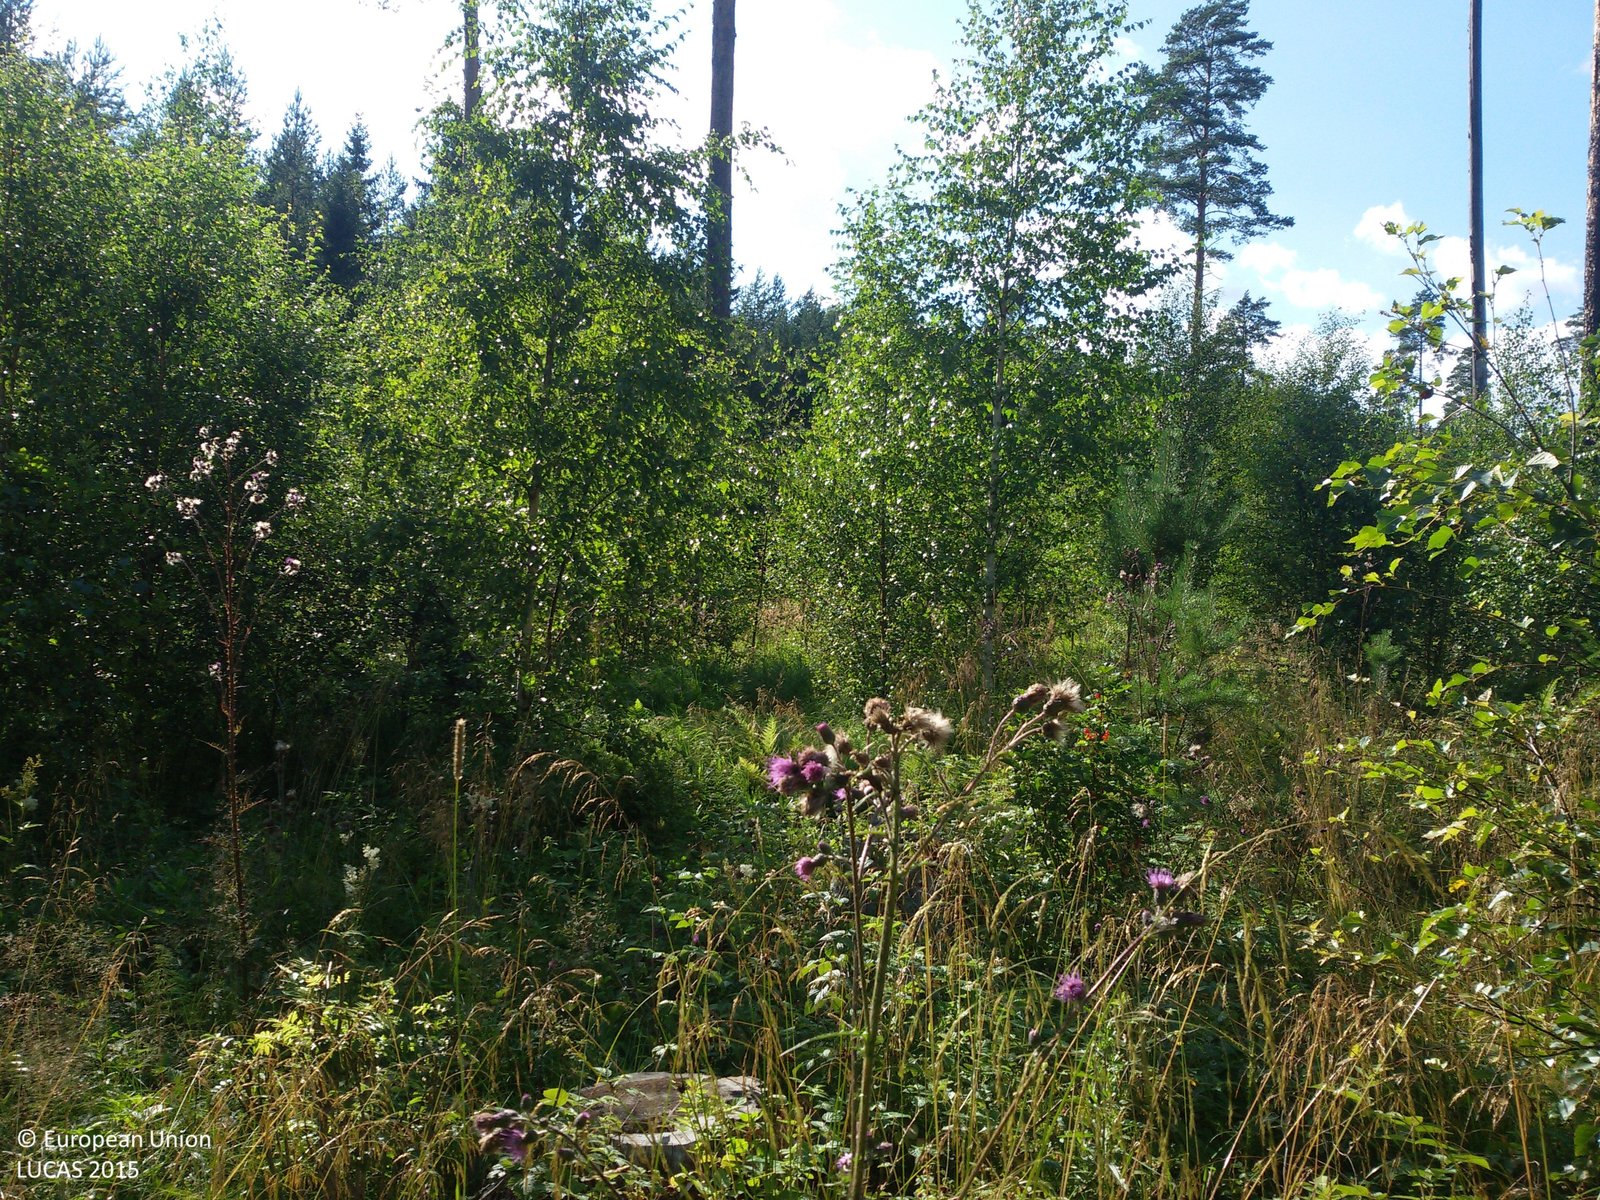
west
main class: Woodland
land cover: Pine dominated mixed woodland
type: boreal forest
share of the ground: 50 - 75 %
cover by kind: coniferous forest trees 40 %, broadleaved forest trees 30 %, herbaceous plants 30 %
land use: Forestry
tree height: < 5 m
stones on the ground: < 10 %
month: August
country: SE
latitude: 60.6250
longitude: 16.5491
